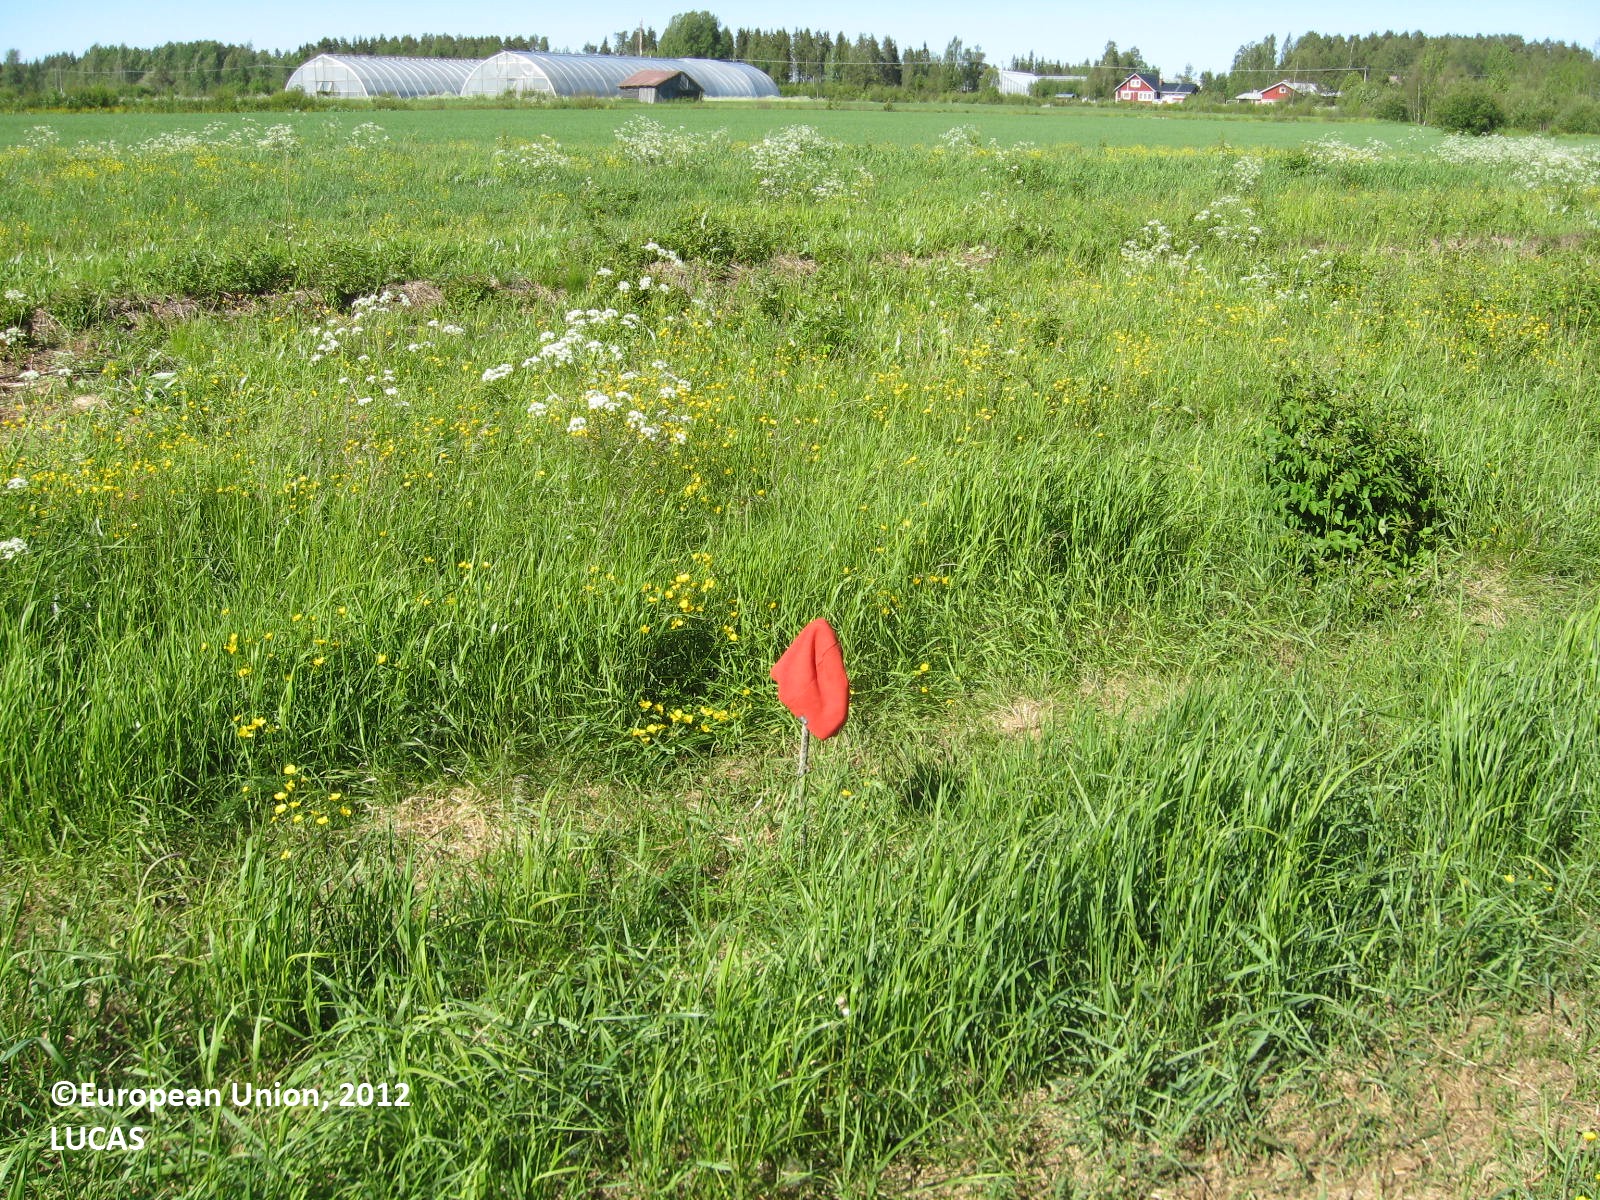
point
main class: Grassland
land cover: Spontaneously vegetated surfaces
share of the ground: > 75 %
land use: Fallow land
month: June
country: FI
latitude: 62.7368
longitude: 21.2513
